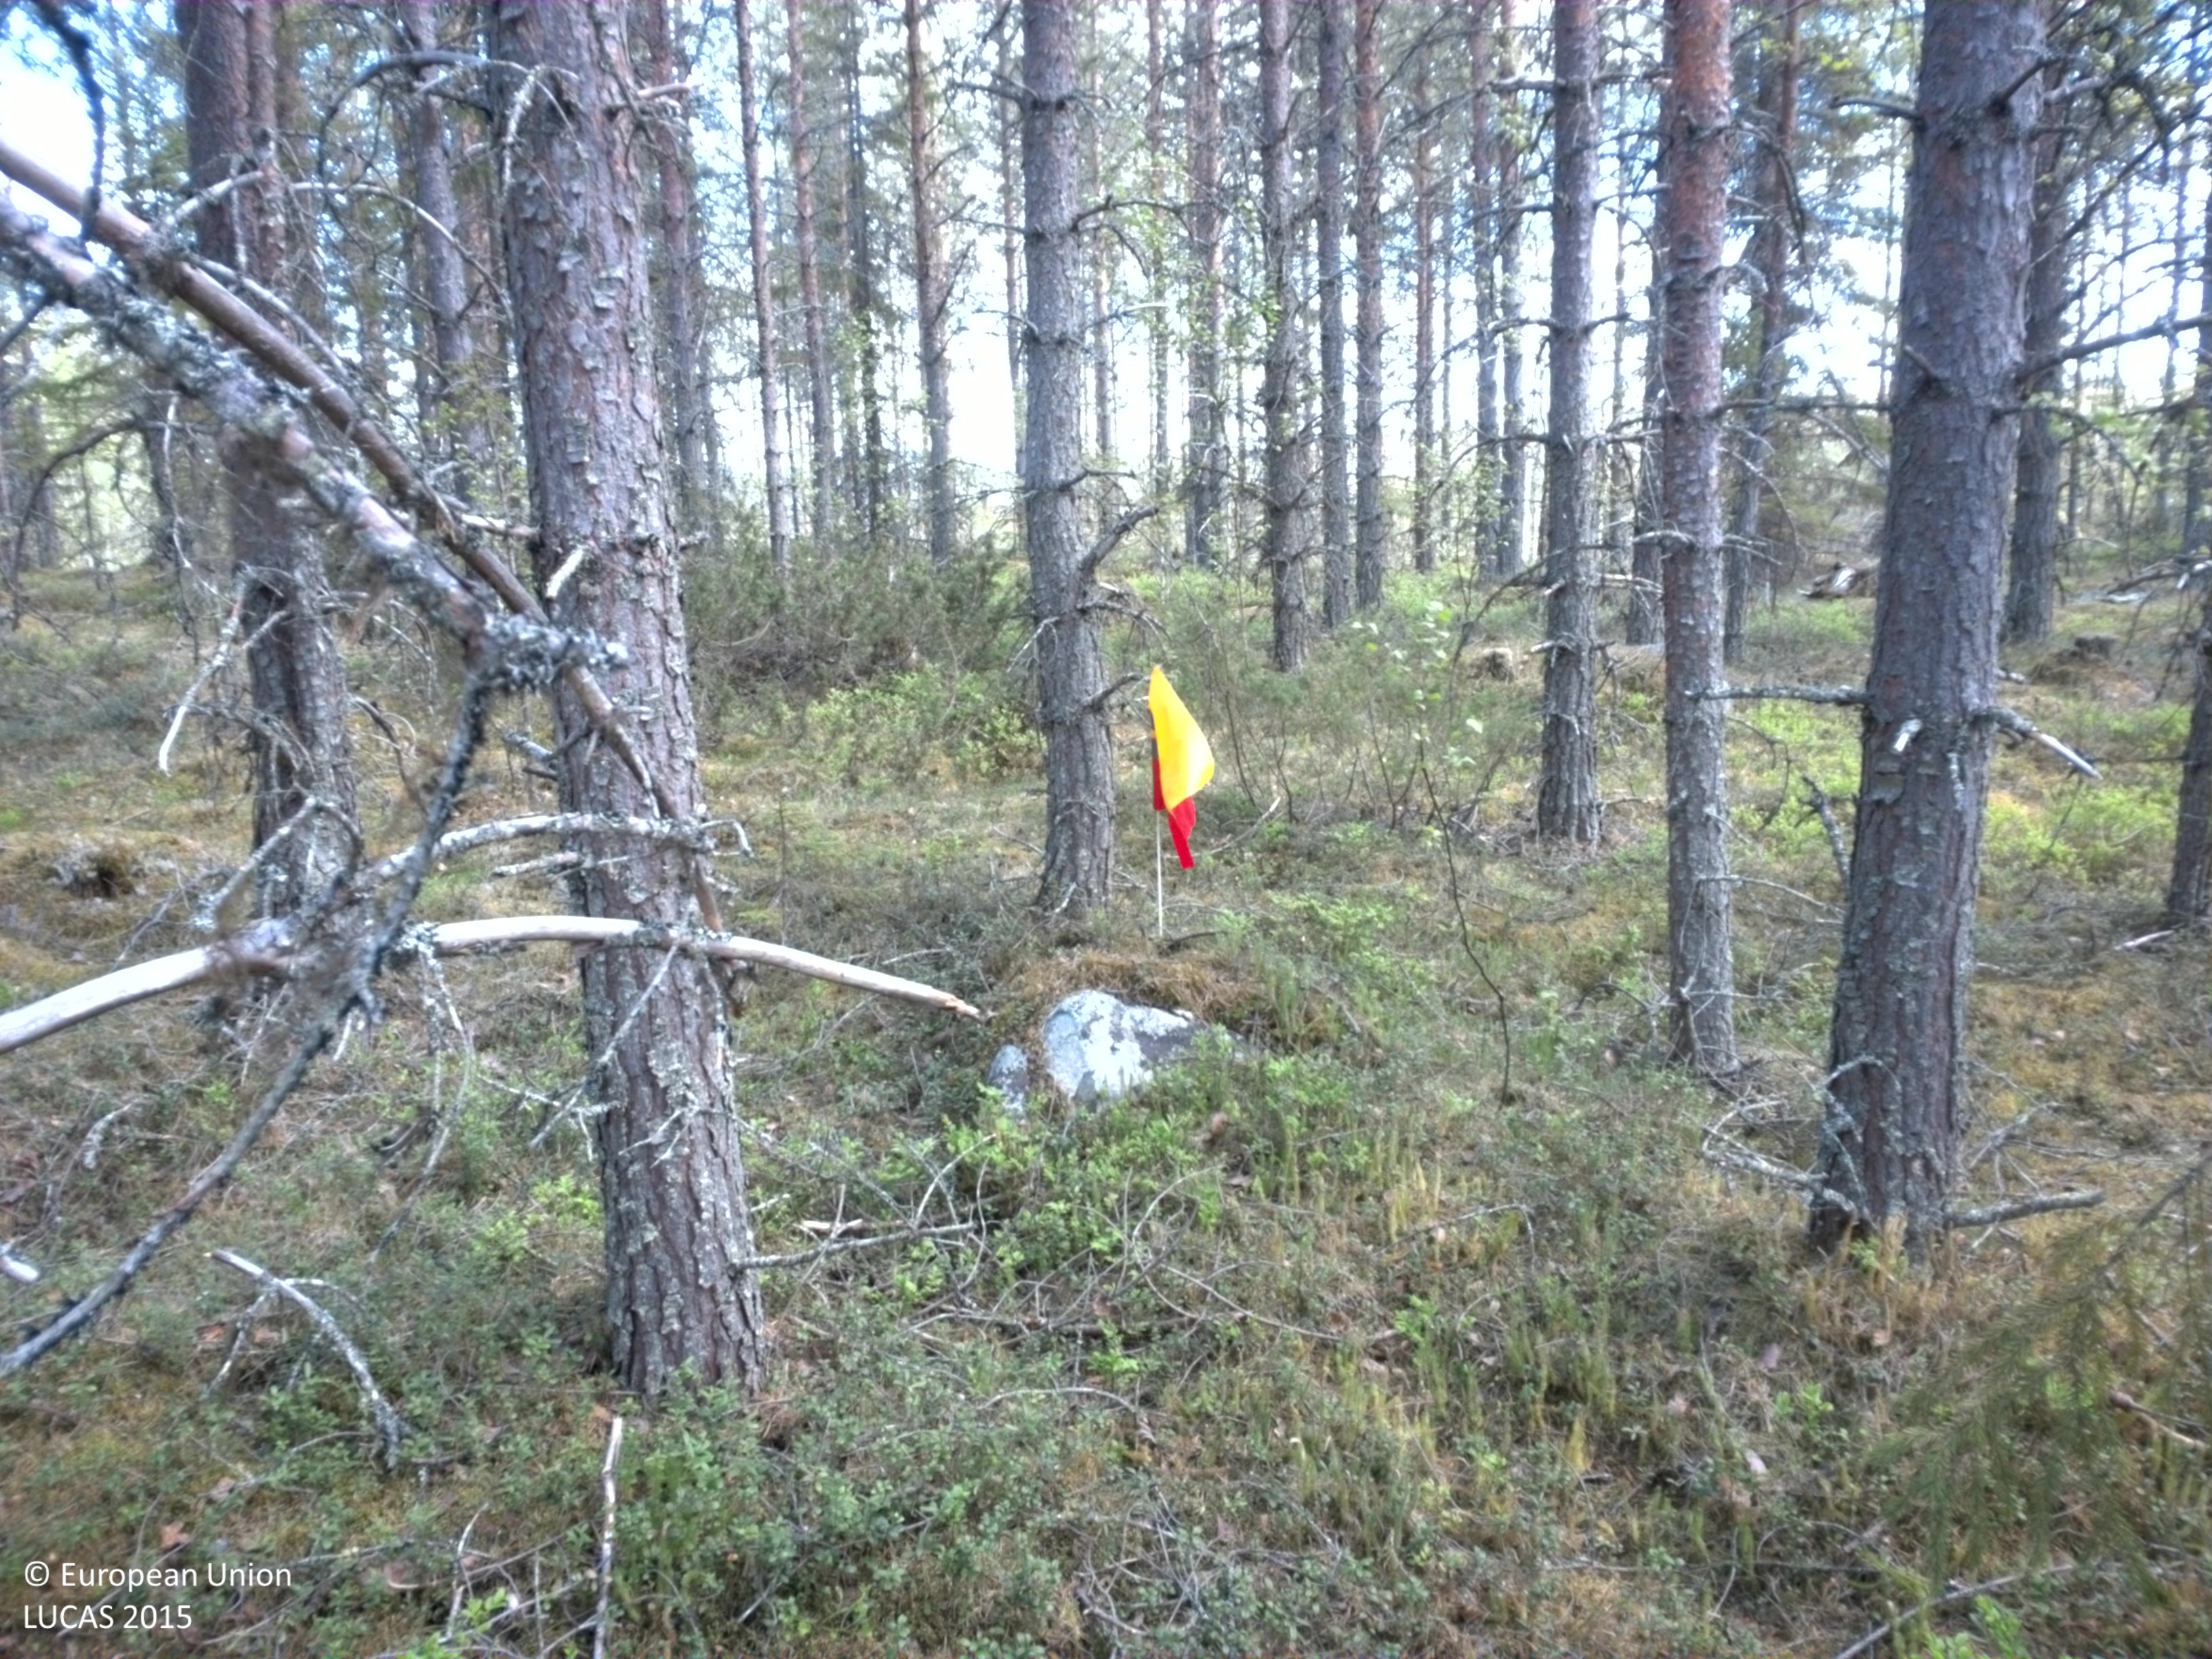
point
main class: Woodland
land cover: Pine dominated coniferous woodland
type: boreal forest
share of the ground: 50 - 75 %
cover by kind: coniferous forest trees 45 %, lichens and mosses 25 %, herbaceous plants 15 %, broadleaved forest trees 10 %, shrubs 5 %
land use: Forestry
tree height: > 5 m
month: June
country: SE
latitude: 64.2505
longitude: 17.2515
